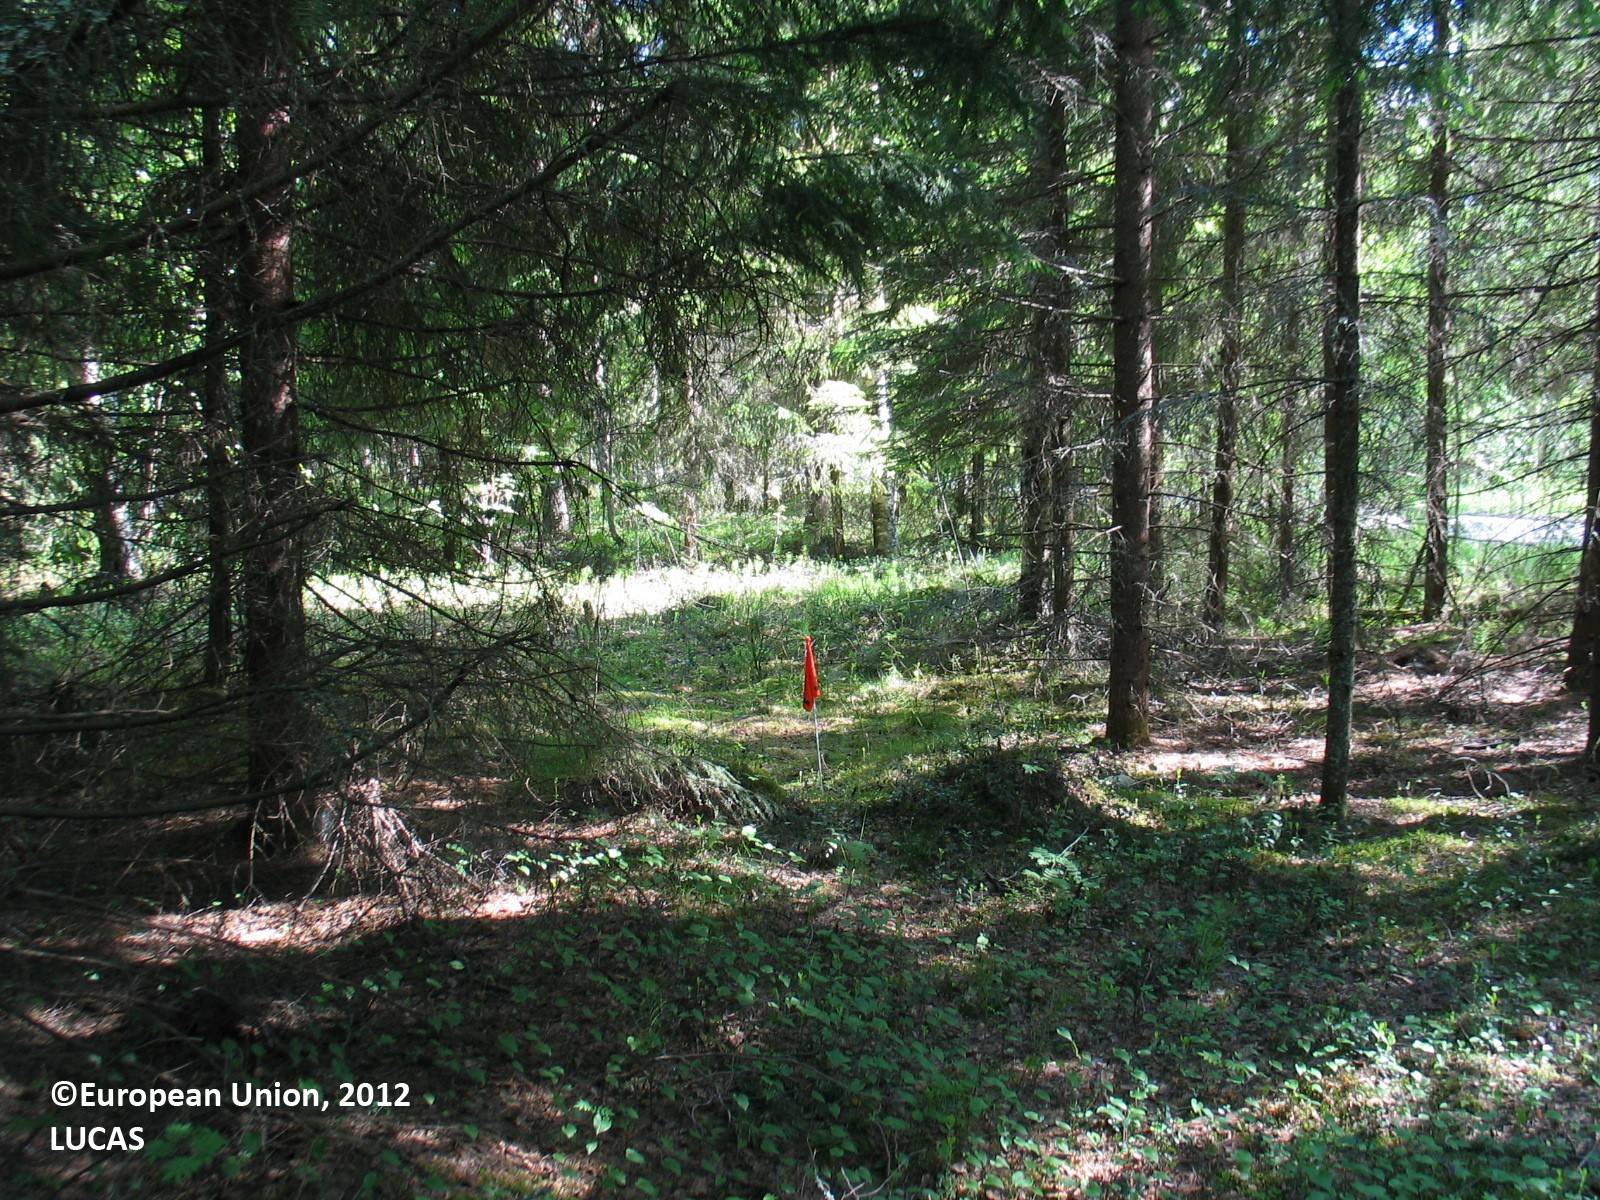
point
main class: Woodland
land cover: Spruce dominated coniferous woodland
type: boreal forest
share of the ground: > 75 %
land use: Forestry
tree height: > 5 m
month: June
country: FI
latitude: 65.1018
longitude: 25.3859
